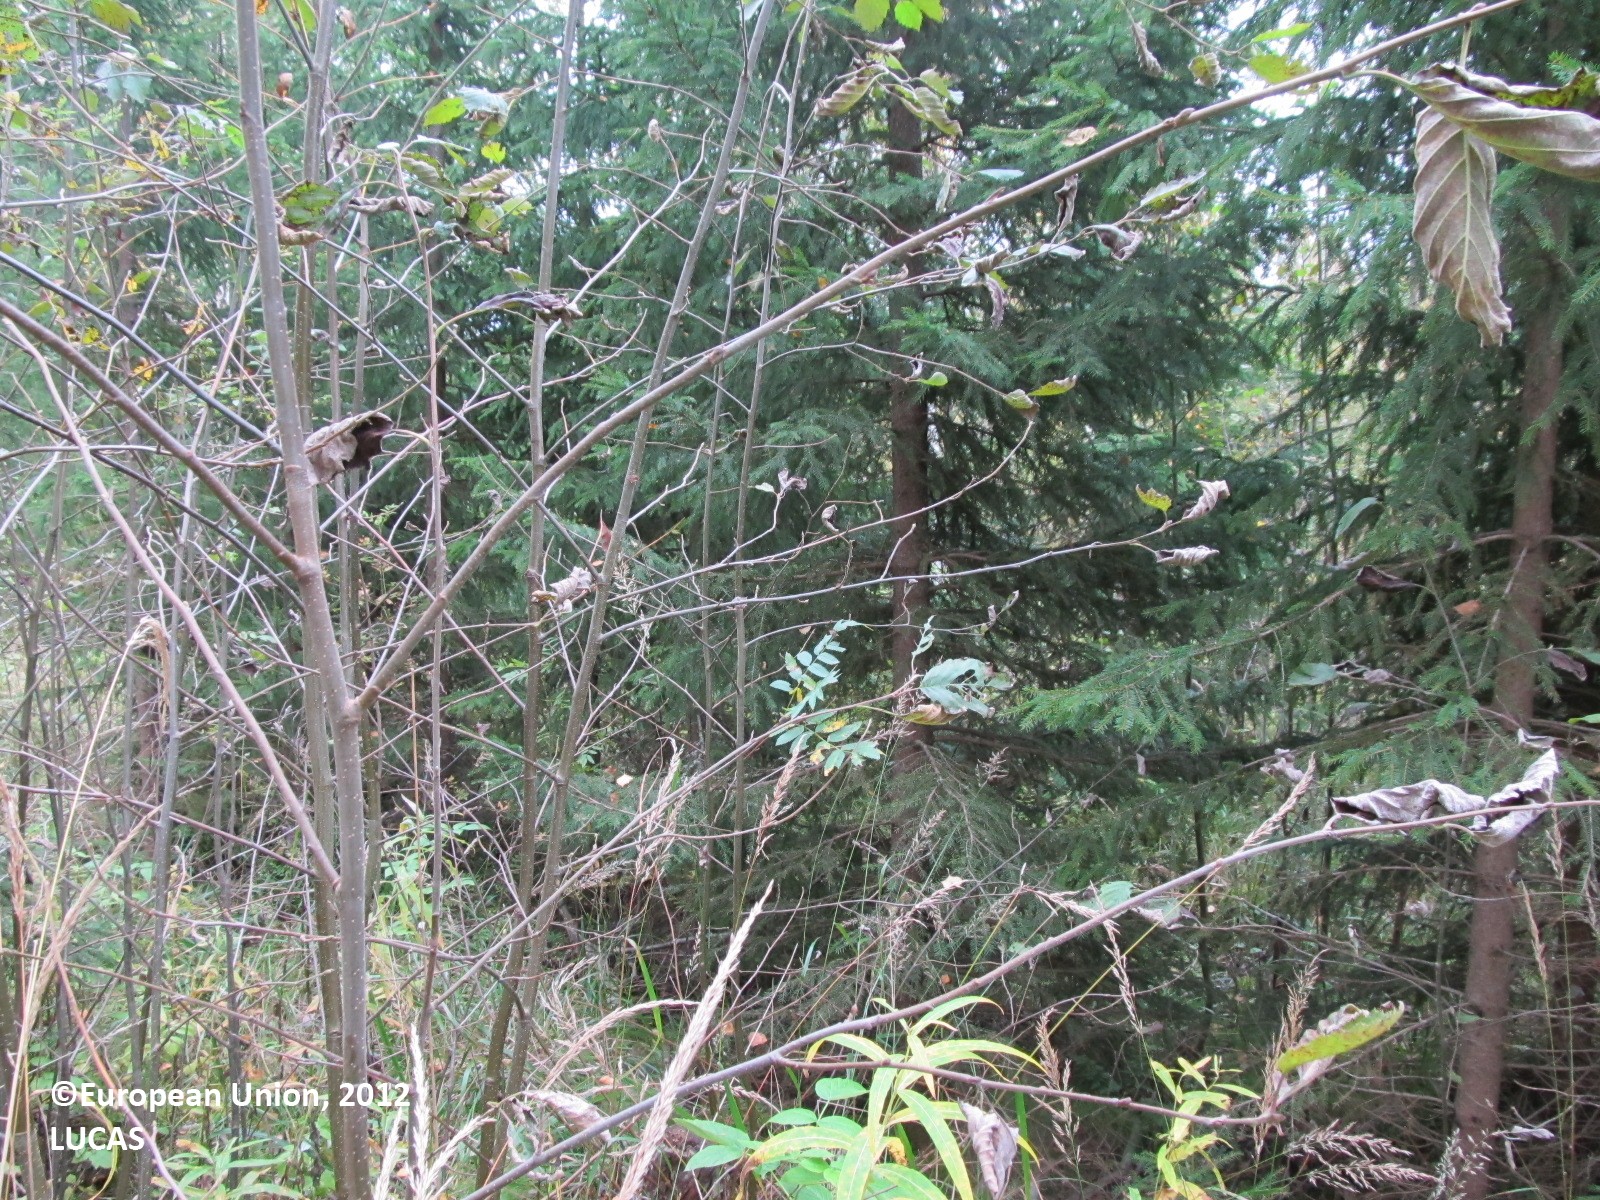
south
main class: Woodland
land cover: Broadleaved woodland
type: boreal forest
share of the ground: 50 - 75 %
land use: Forestry
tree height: > 5 m
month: September
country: FI
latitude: 63.0427
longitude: 28.1151
